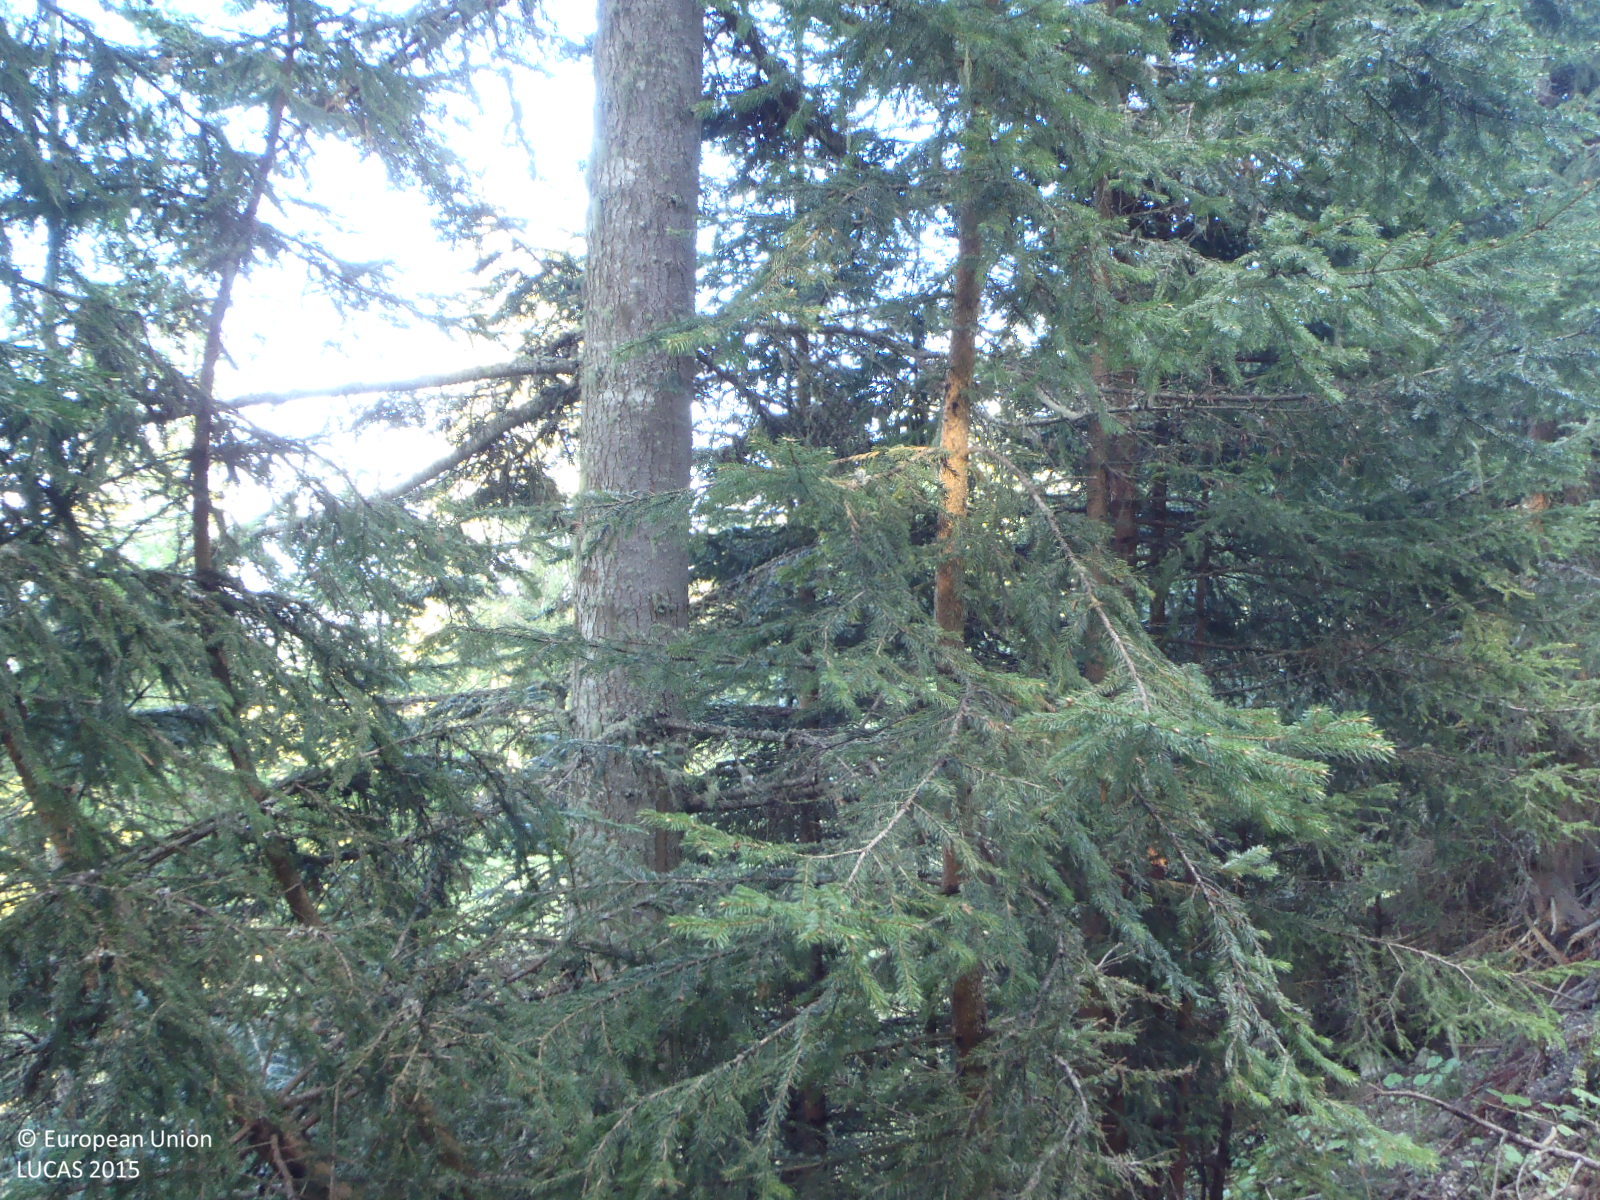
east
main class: Woodland
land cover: Spruce dominated coniferous woodland
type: alpine coniferous forest
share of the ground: > 75 %
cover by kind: coniferous forest trees 75 %, shrubs 20 %, herbaceous plants 5 %
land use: Forestry
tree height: > 5 m
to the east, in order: Spruce dominated coniferous woodland; Grassland without tree/shrub cover; Spruce dominated coniferous woodland; Grassland without tree/shrub cover; Other structural elements; Grassland without tree/shrub cover; Spruce dominated coniferous woodland; Rivers and streams; Spruce dominated coniferous woodland; Grassland without tree/shrub cover; Spruce dominated coniferous woodland; Rivers and streams; Spruce dominated coniferous woodland; Rivers and streams; Spruce dominated coniferous woodland; Rivers and streams; Spruce dominated coniferous woodland
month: May
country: AT
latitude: 47.3588
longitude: 13.4538
